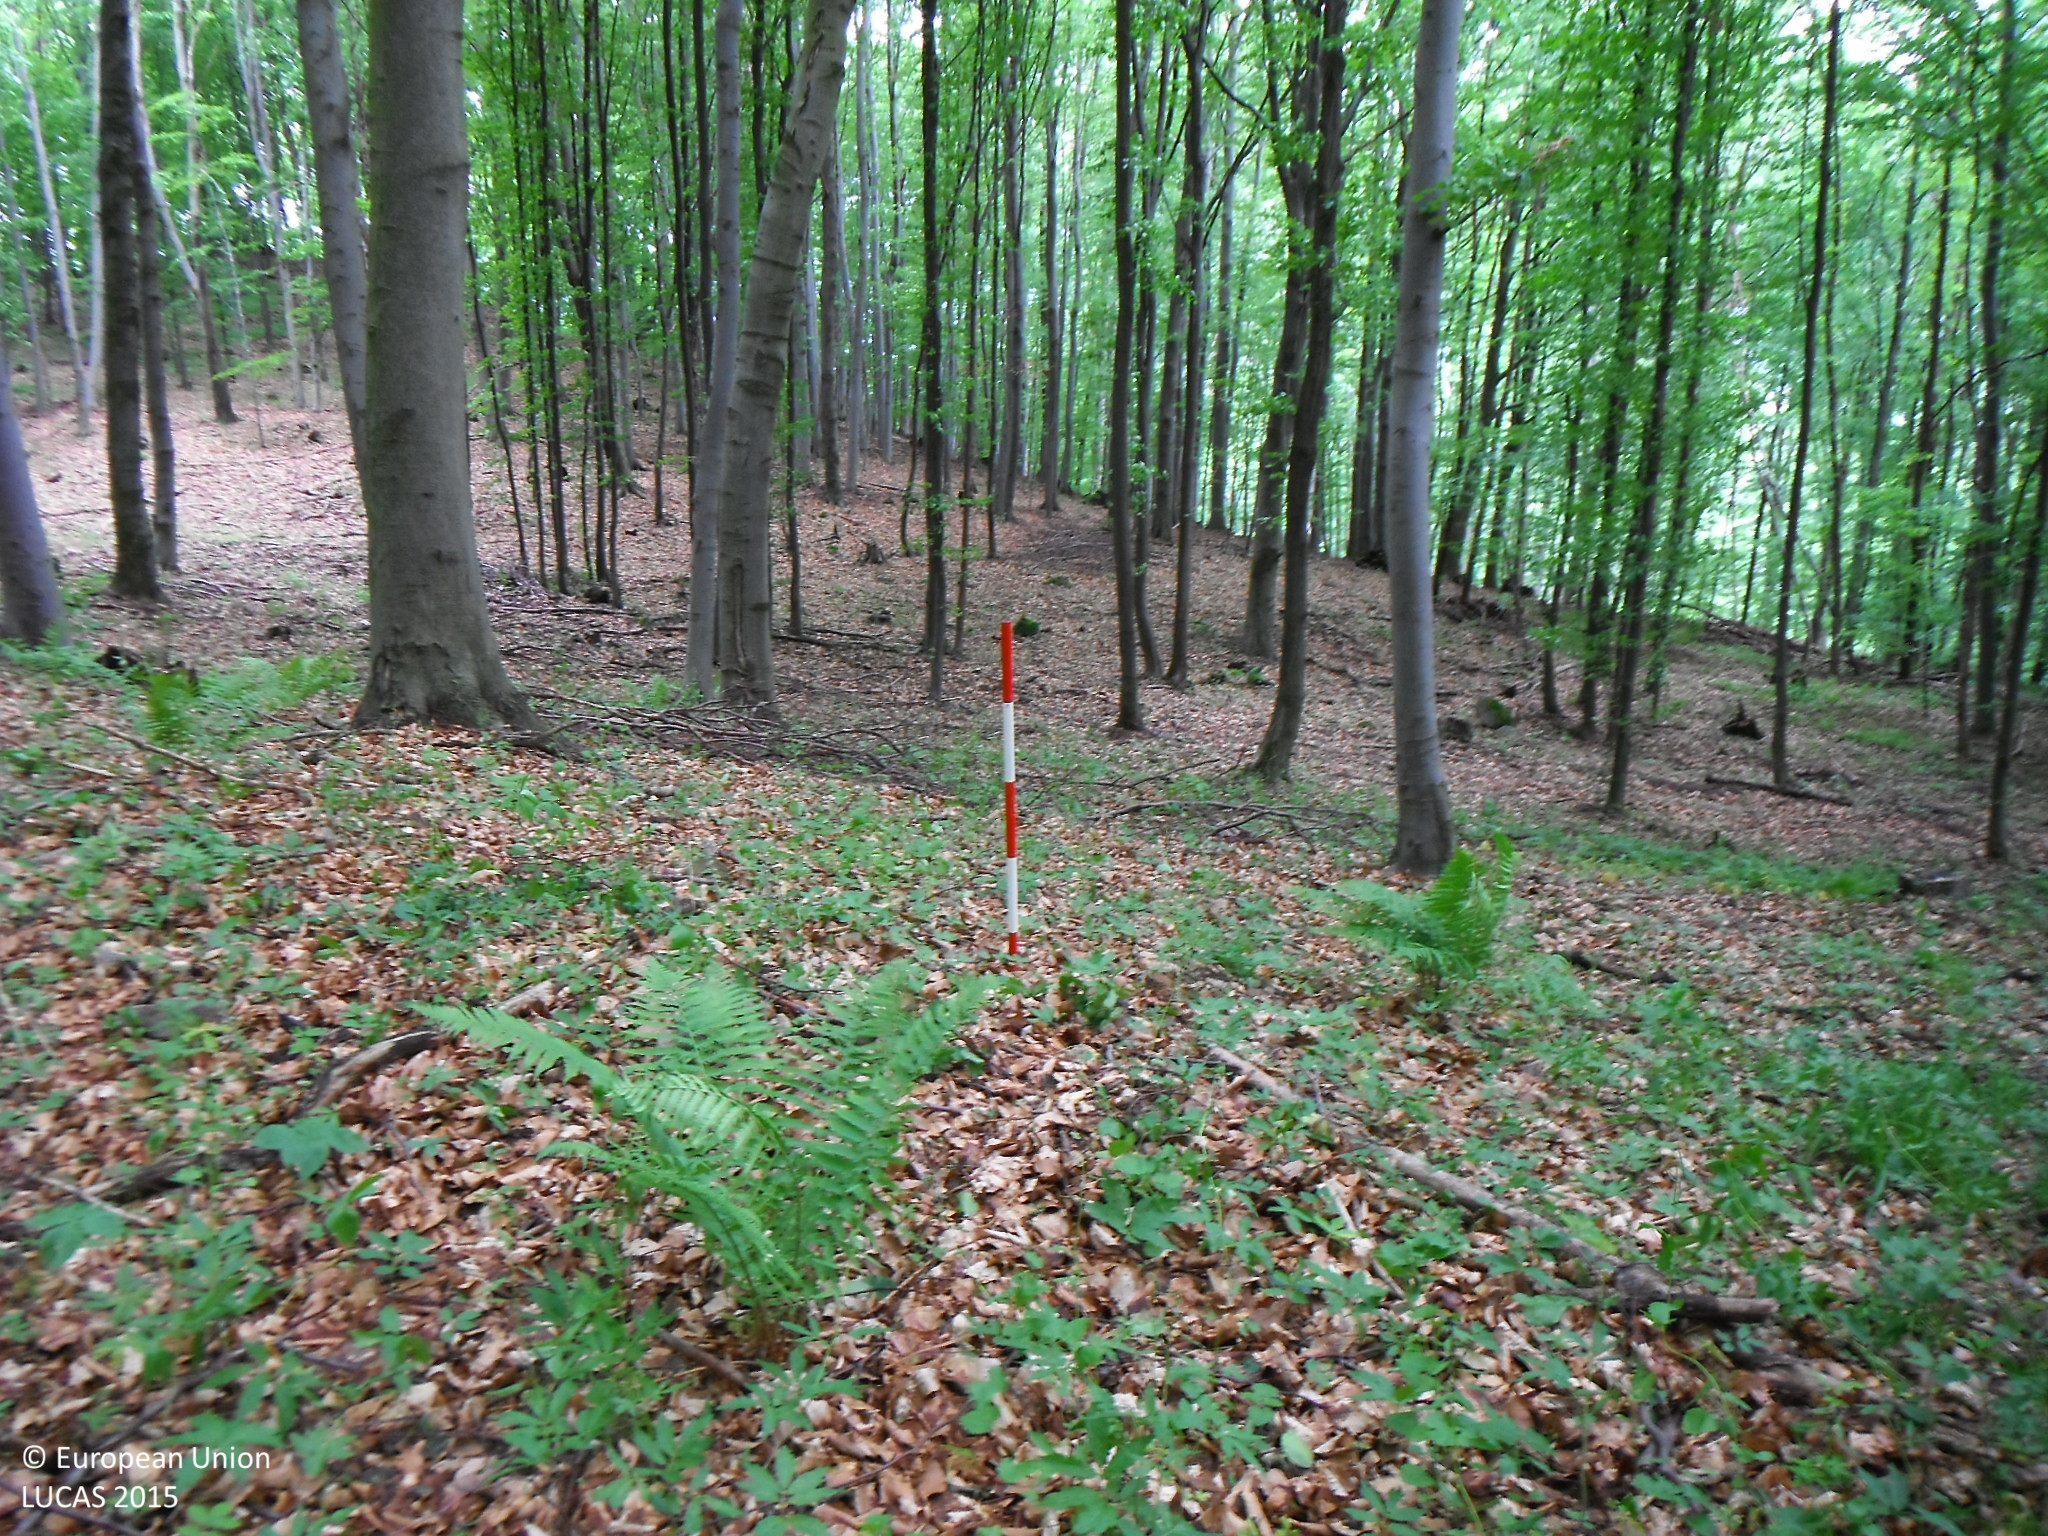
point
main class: Woodland
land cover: Broadleaved woodland
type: beech forest
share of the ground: > 75 %
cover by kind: broadleaved forest trees 100 %
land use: Forestry
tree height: > 5 m
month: May
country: SK
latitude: 48.9801
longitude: 21.3459
